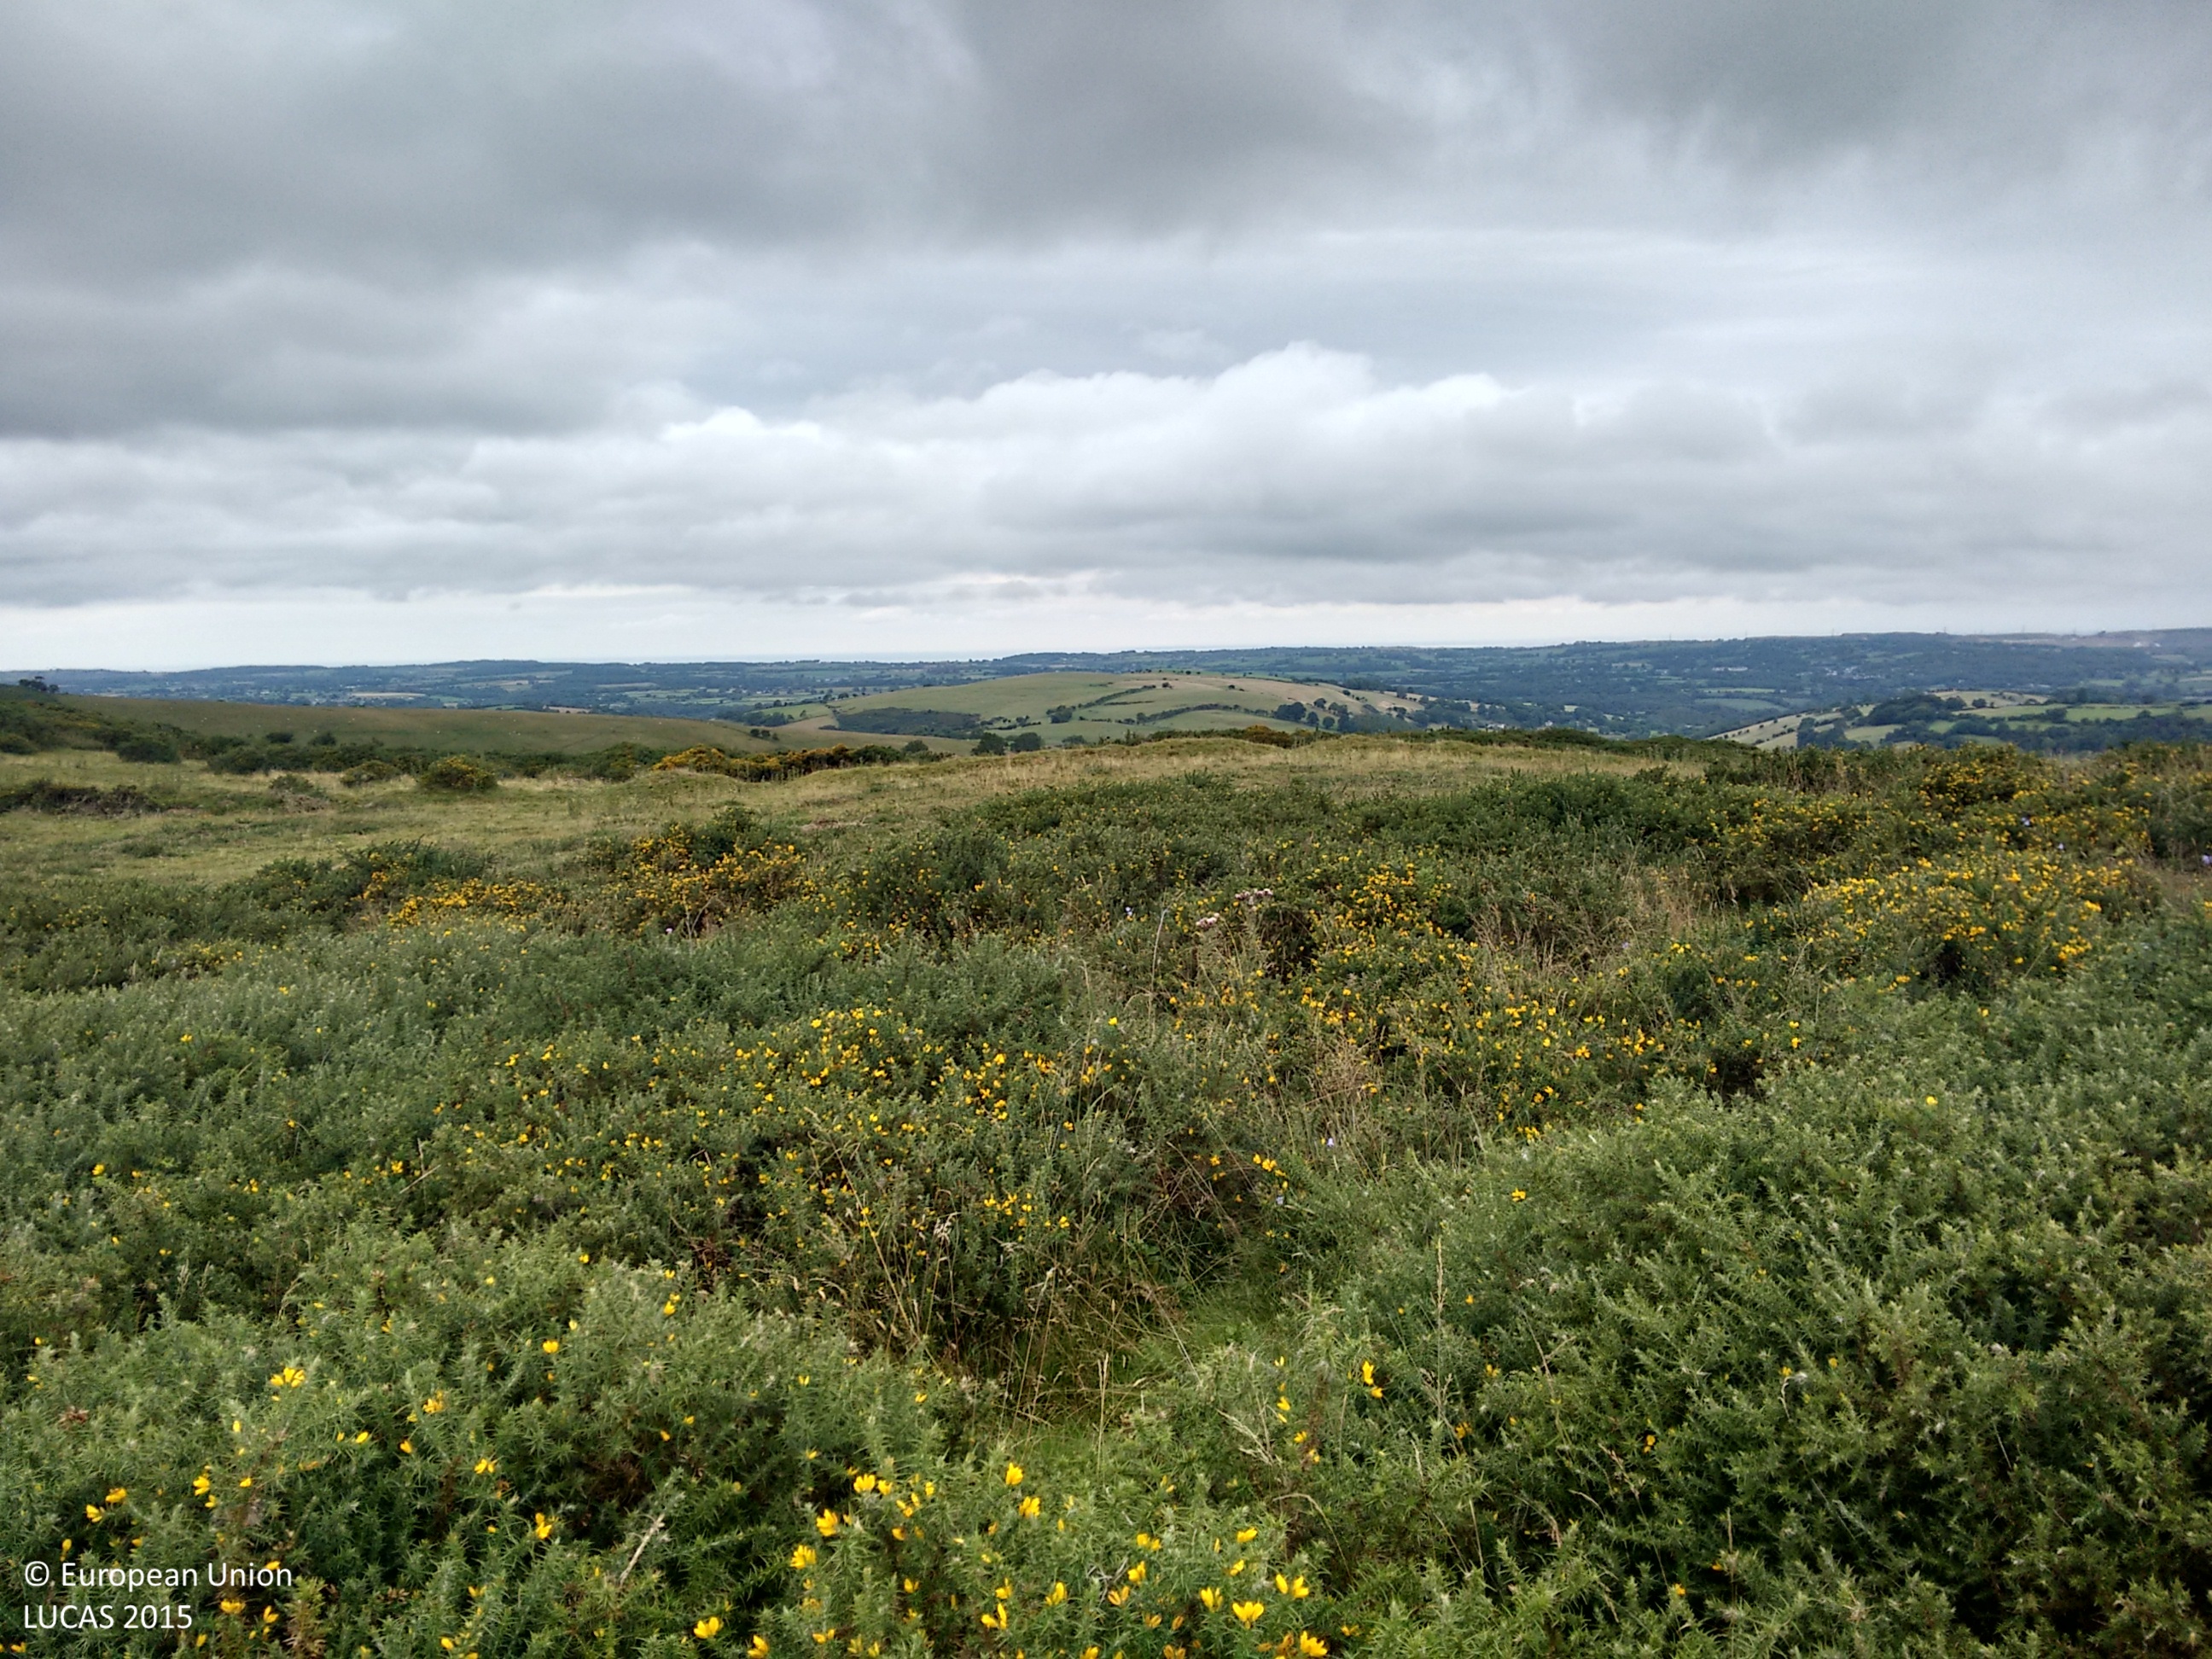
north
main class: Shrubland
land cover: Shrubland without tree cover
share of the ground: > 75 %
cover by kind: shrubs 100 %
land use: Agriculture (excluding fallow land and kitchen gardens)
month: August
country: GB
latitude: 53.1932
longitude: -3.2963
